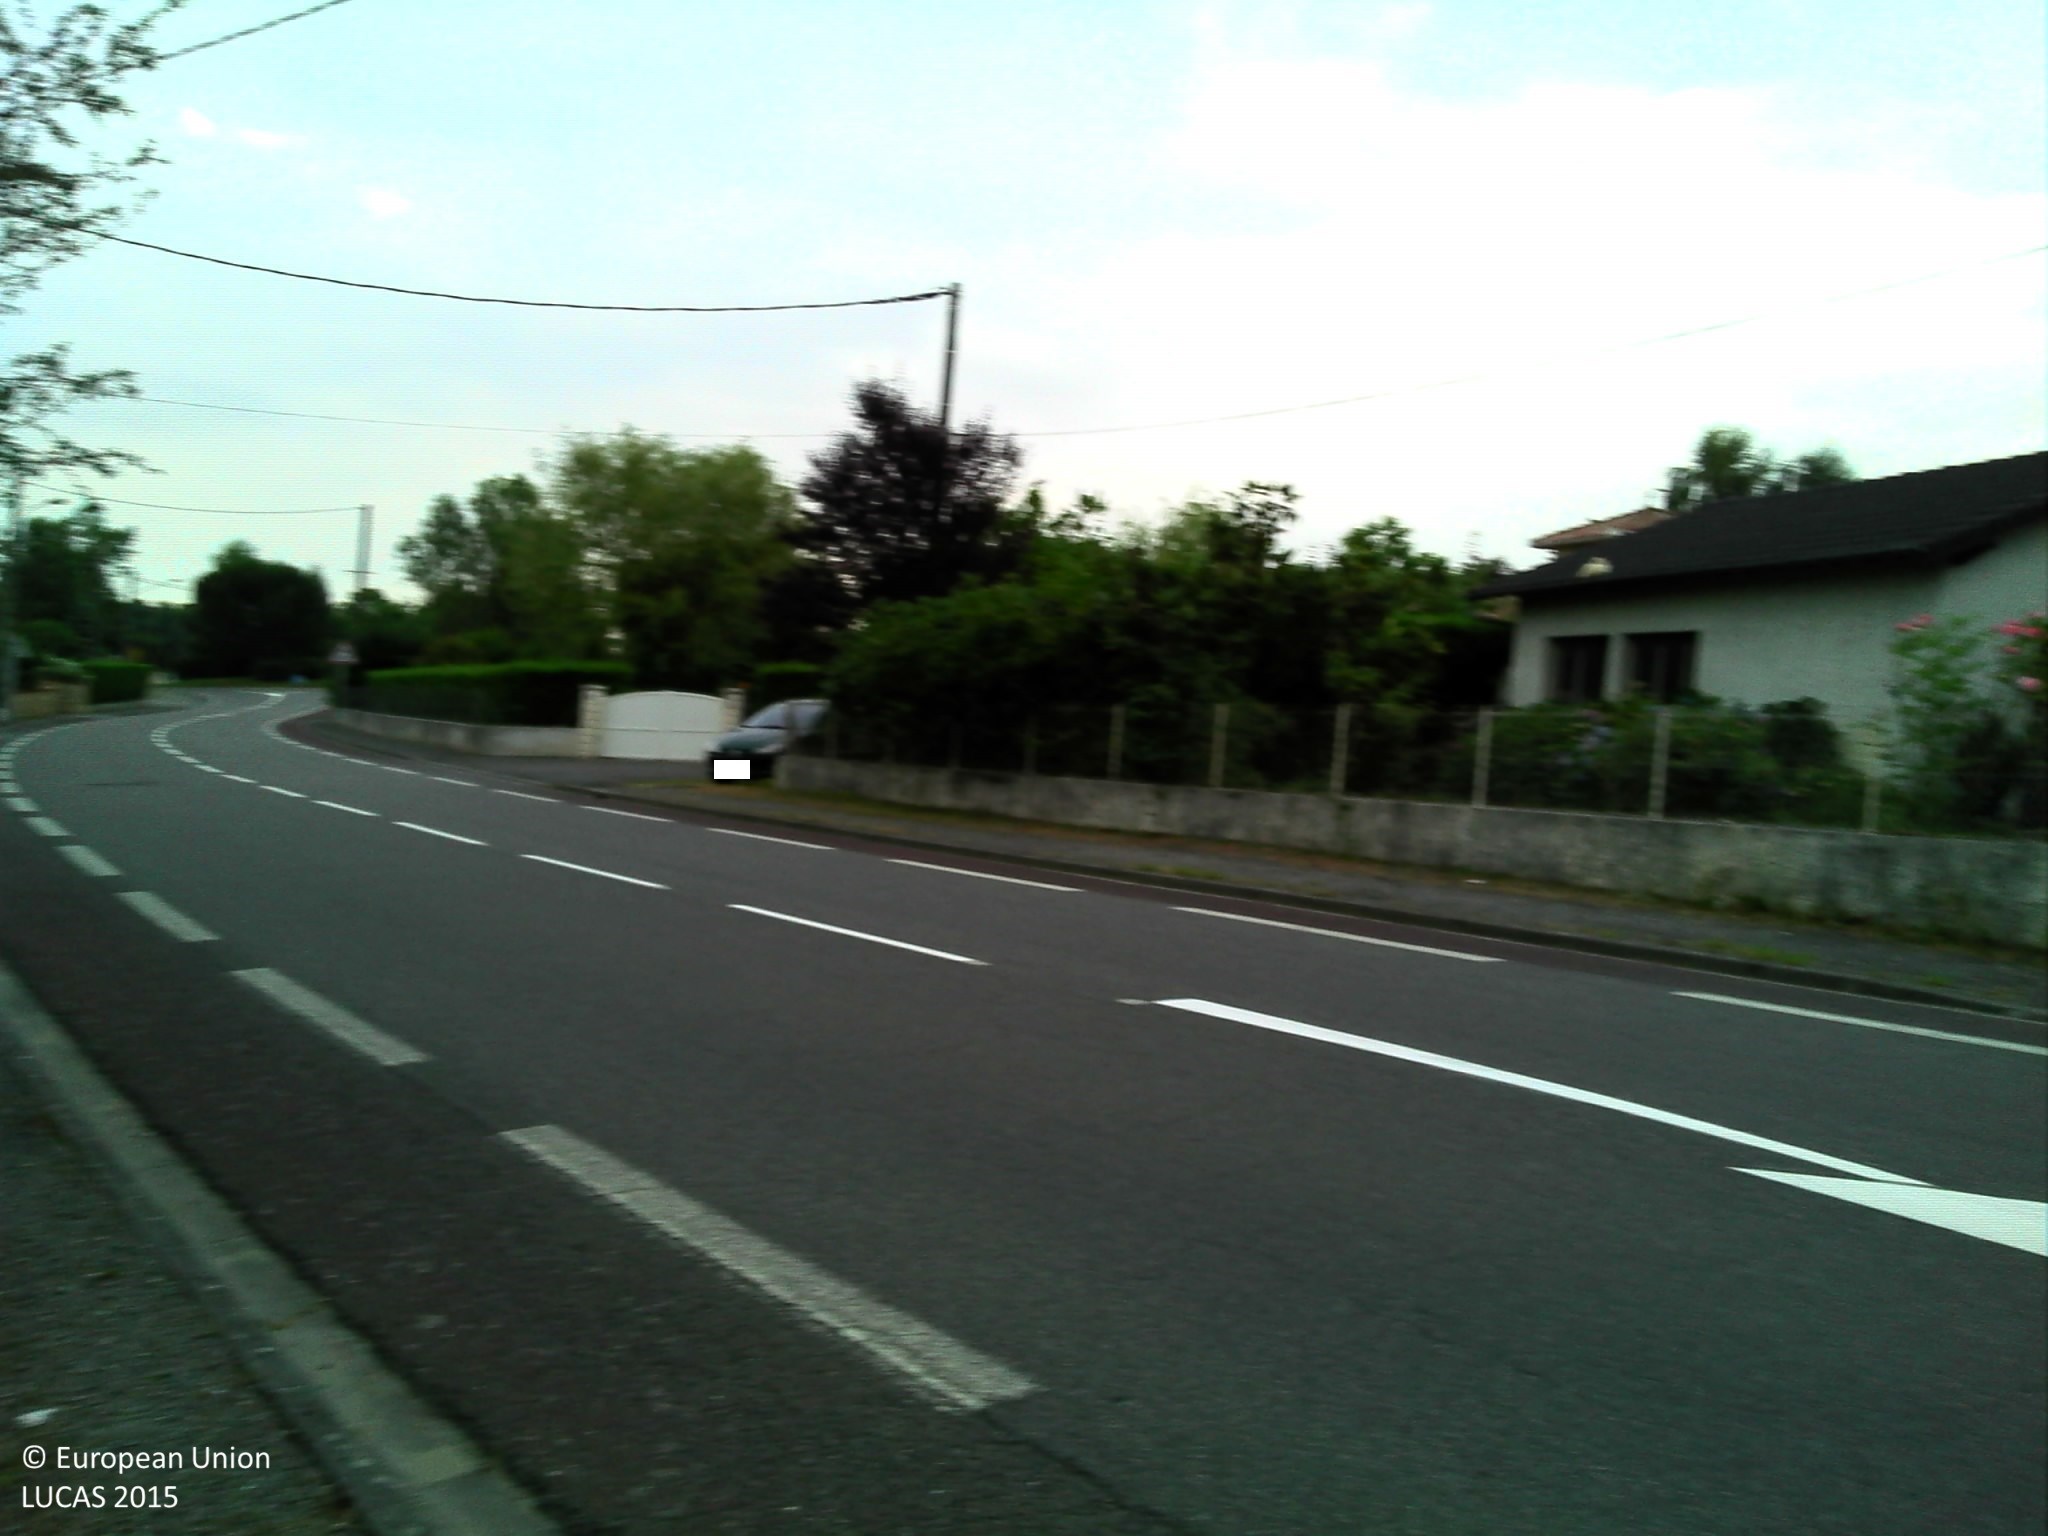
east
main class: Woodland
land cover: Spruce dominated mixed woodland
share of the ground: > 75 %
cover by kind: broadleaved forest trees 50 %, coniferous forest trees 30 %, shrubs 10 %, herbaceous plants 10 %
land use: Residential
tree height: > 5 m
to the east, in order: Spruce dominated mixed woodland; Artificial constructions in urban areas; Paved roads, cycling and walking lanes; Grassland with sparse tree/shrub cover; Artificial constructions in urban areas
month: July
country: FR
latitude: 43.1218
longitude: 0.7715
